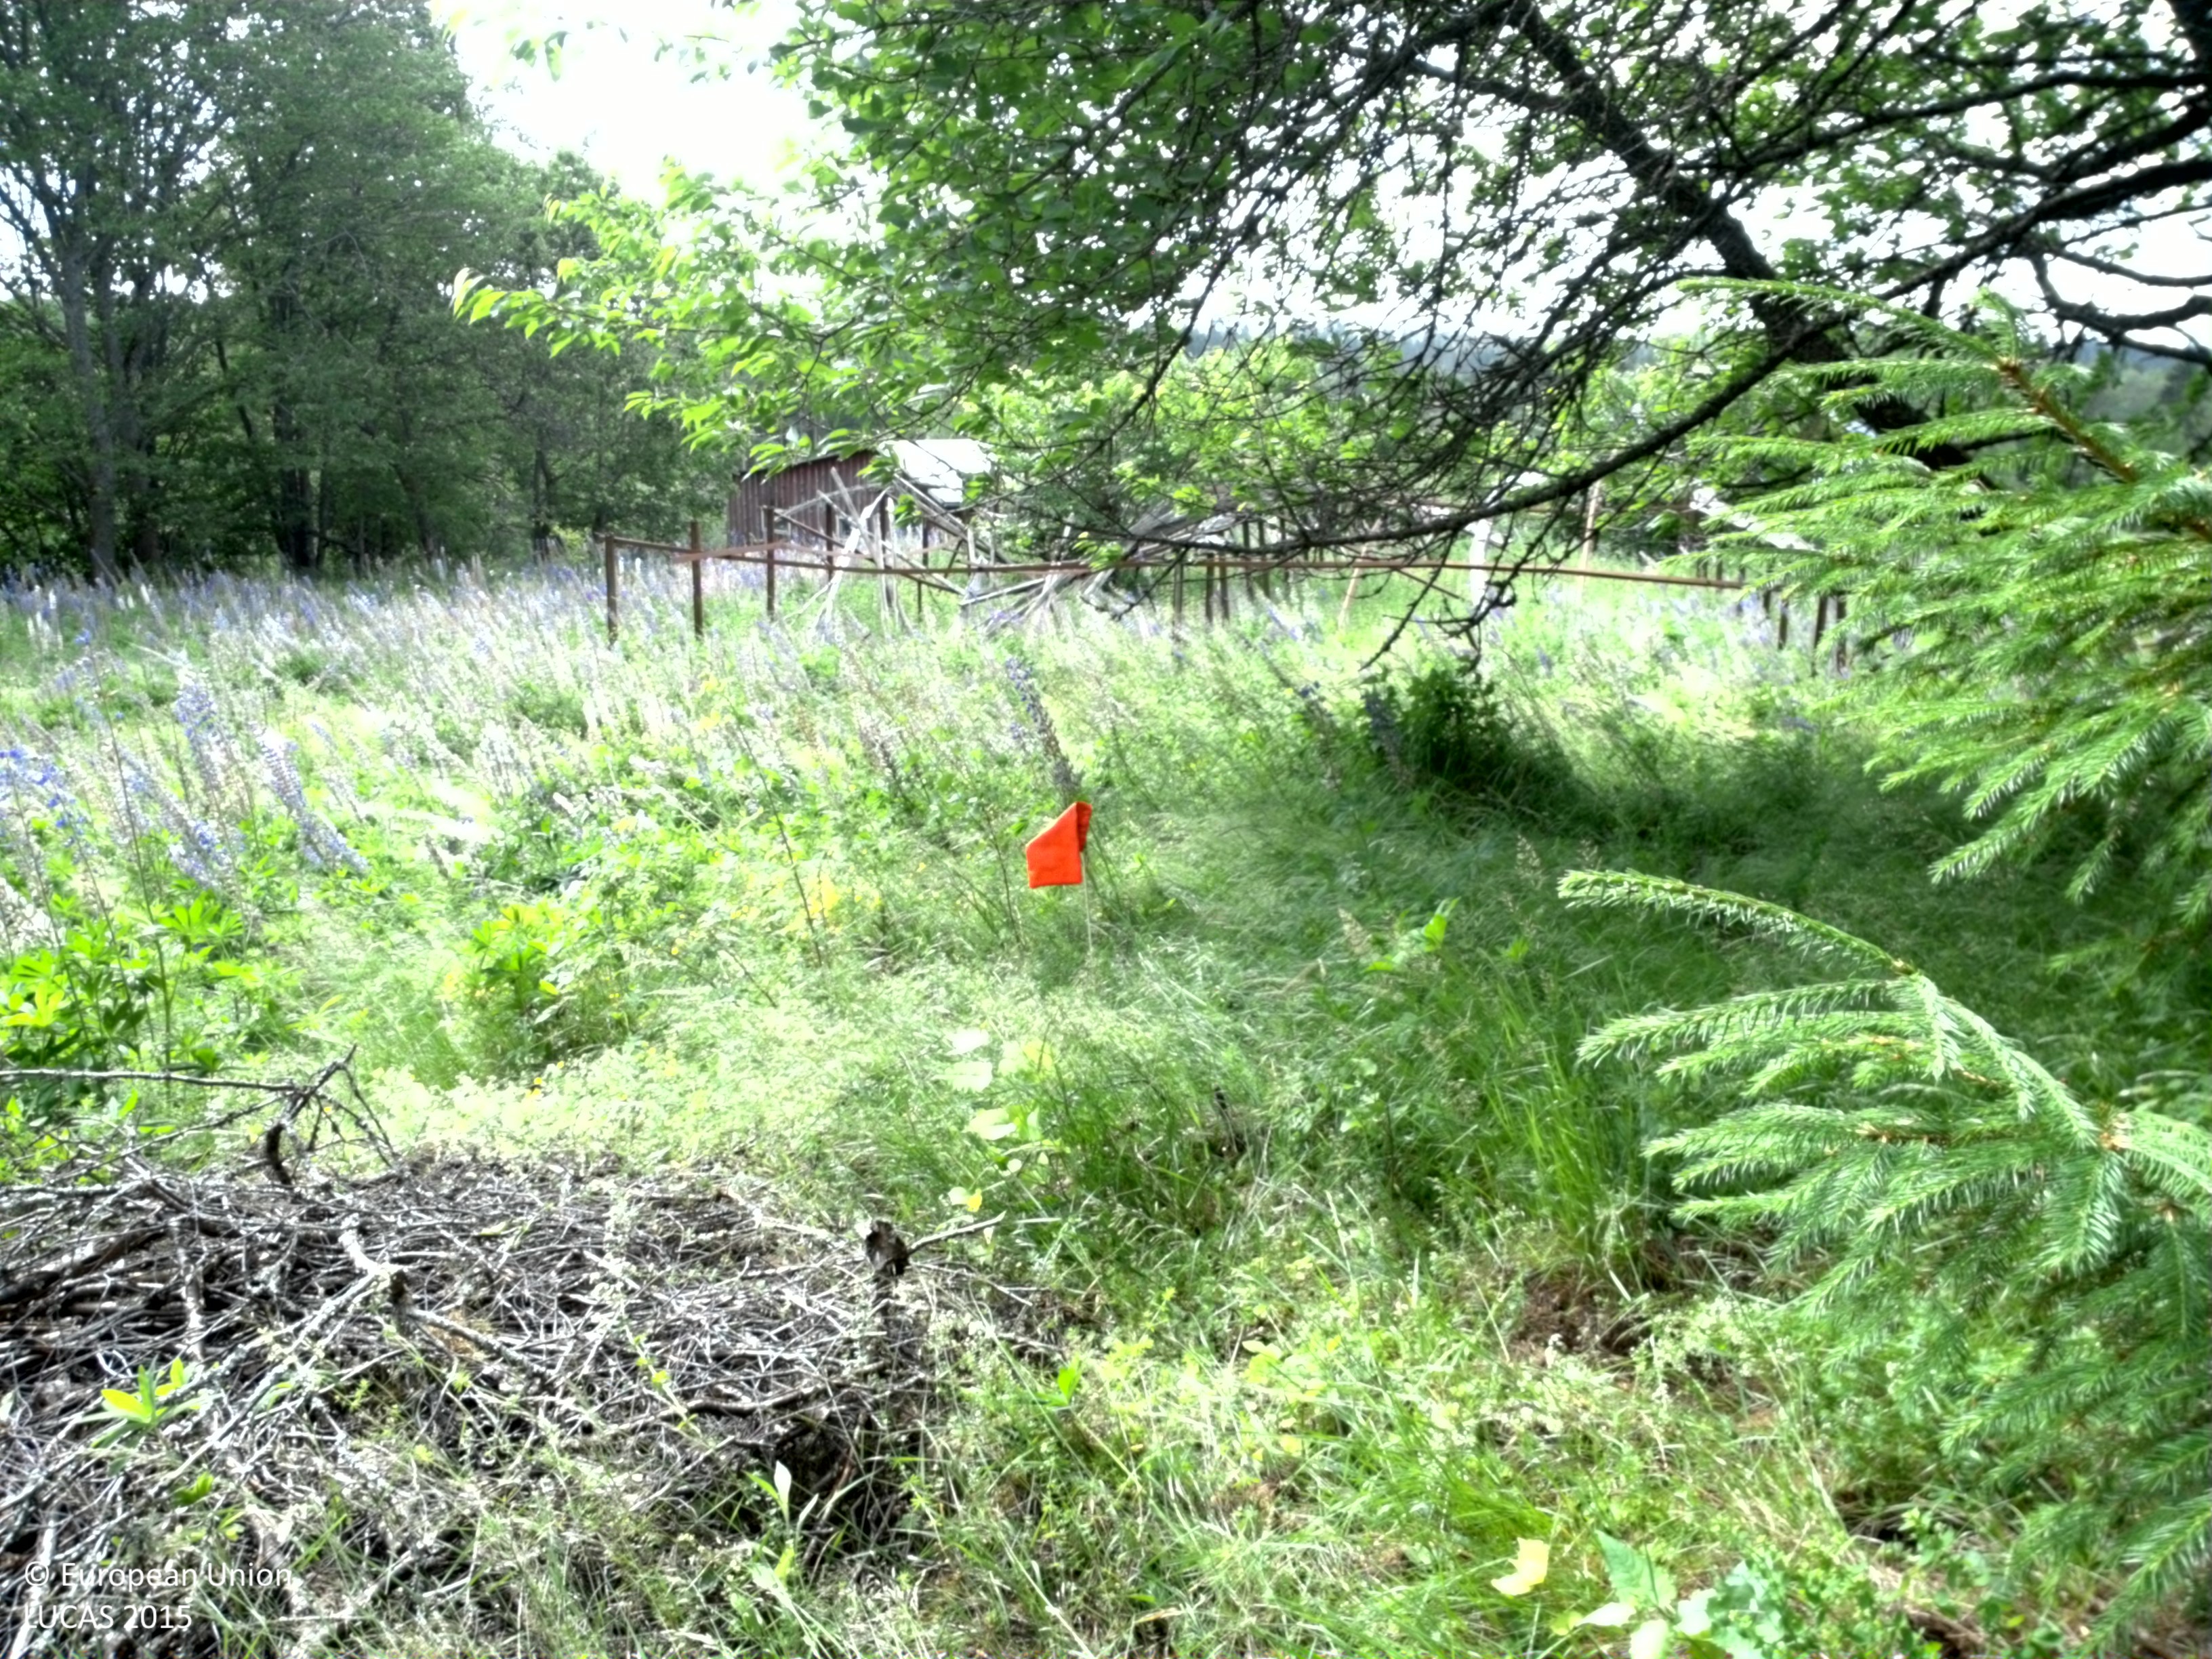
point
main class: Grassland
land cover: Spontaneously vegetated surfaces
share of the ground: > 75 %
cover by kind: herbaceous plants 100 %
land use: Semi-natural and natural areas not in use
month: July
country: SE
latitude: 58.8251
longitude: 14.6171
